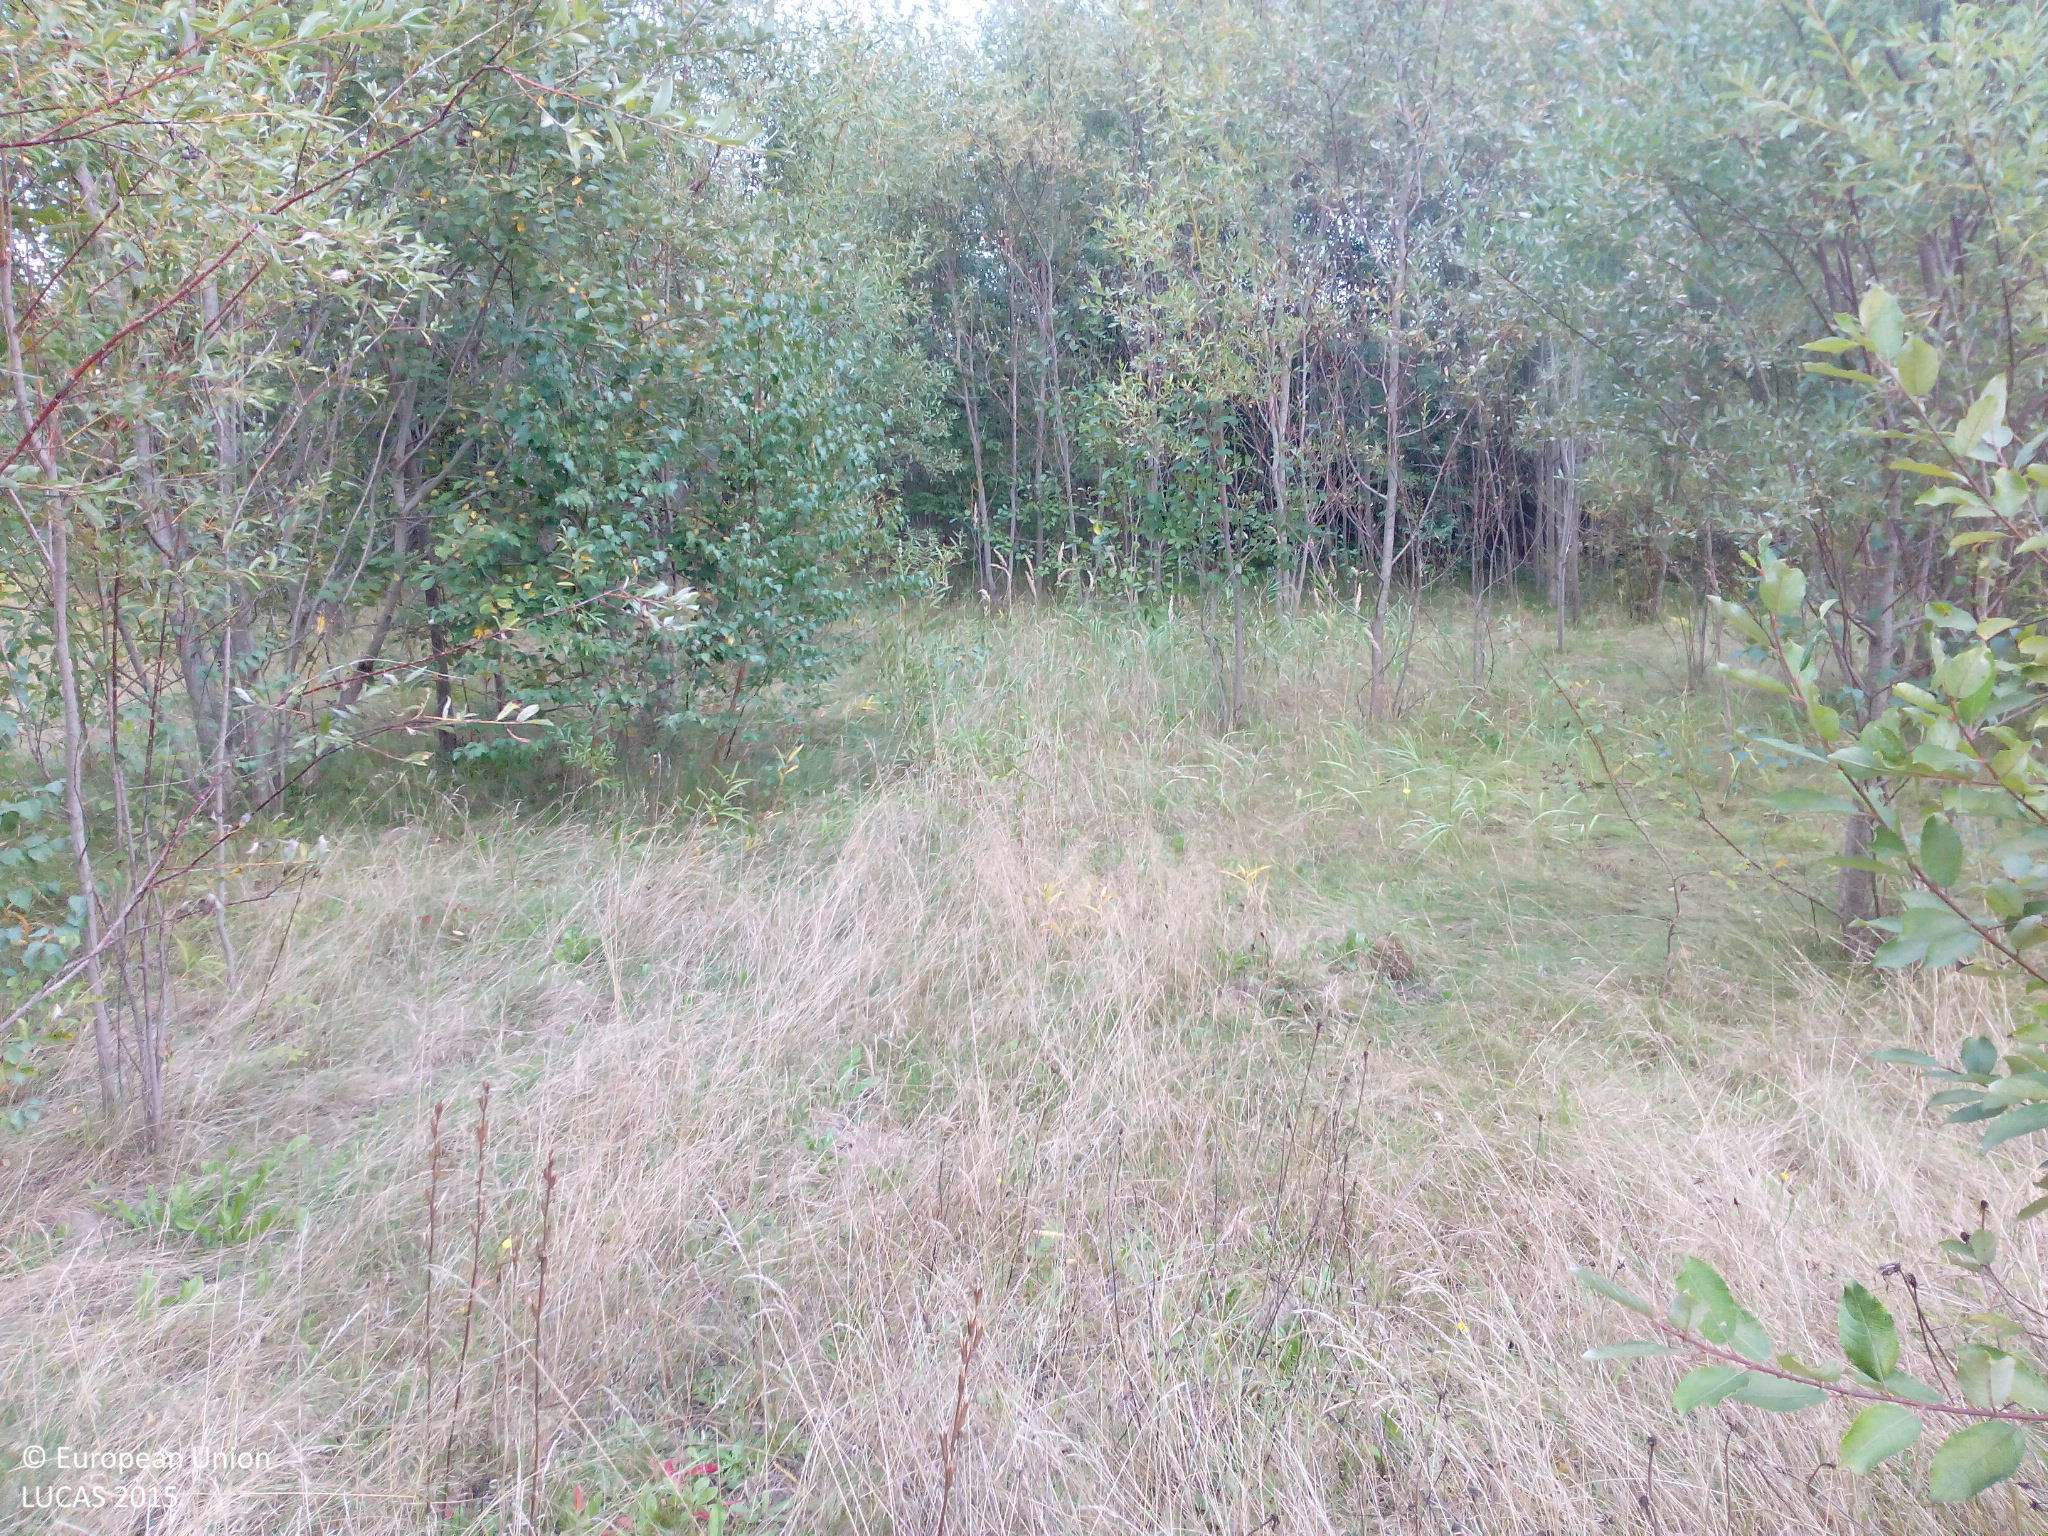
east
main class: Woodland
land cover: Broadleaved woodland
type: mesophytic deciduous forest
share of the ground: 25 - 50 %
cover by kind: herbaceous plants 70 %, broadleaved forest trees 30 %
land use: Semi-natural and natural areas not in use
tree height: > 5 m
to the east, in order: Broadleaved woodland; Tracks; Abandoned hedges; Inland fresh running water; Abandoned hedges; Tracks; Grass margins; Other leguminous and mixtures for fodder
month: September
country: DE
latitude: 48.3764
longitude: 11.4169
